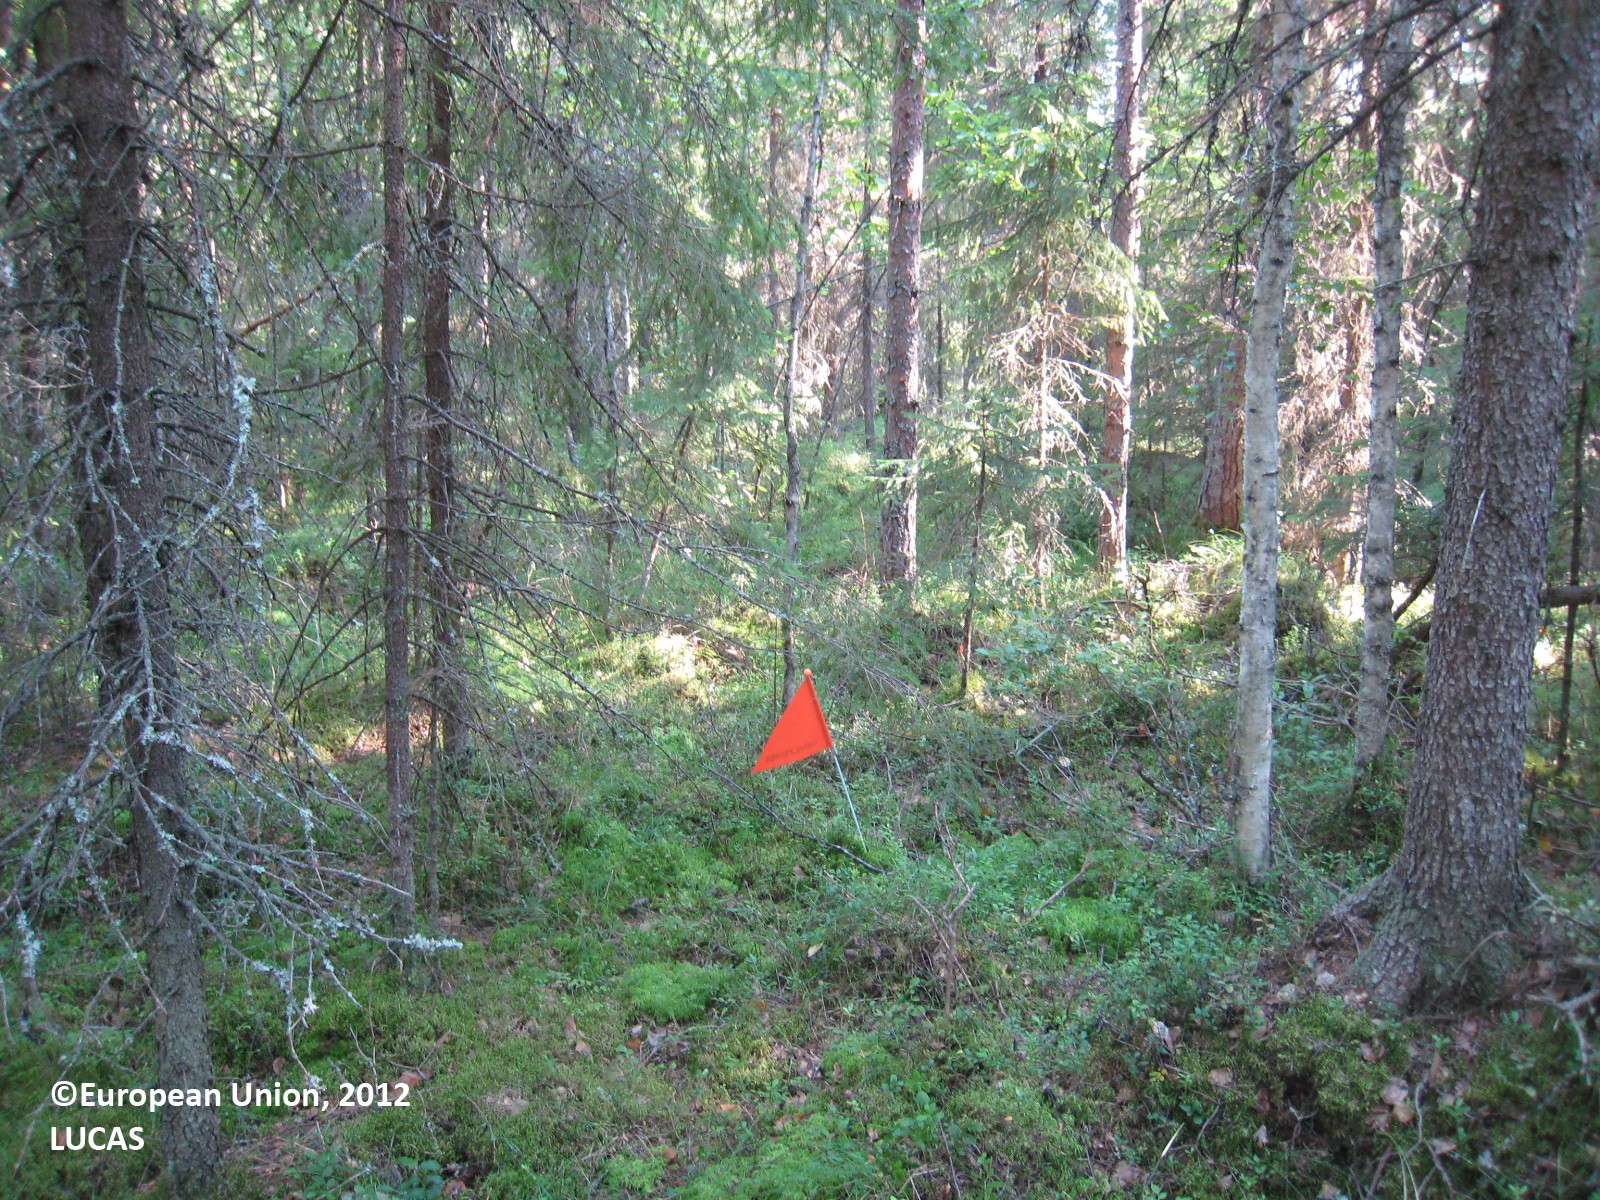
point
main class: Woodland
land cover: Other mixed woodland
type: boreal forest
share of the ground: > 75 %
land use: Forestry
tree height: > 5 m
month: July
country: FI
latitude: 62.6154
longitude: 27.3295
